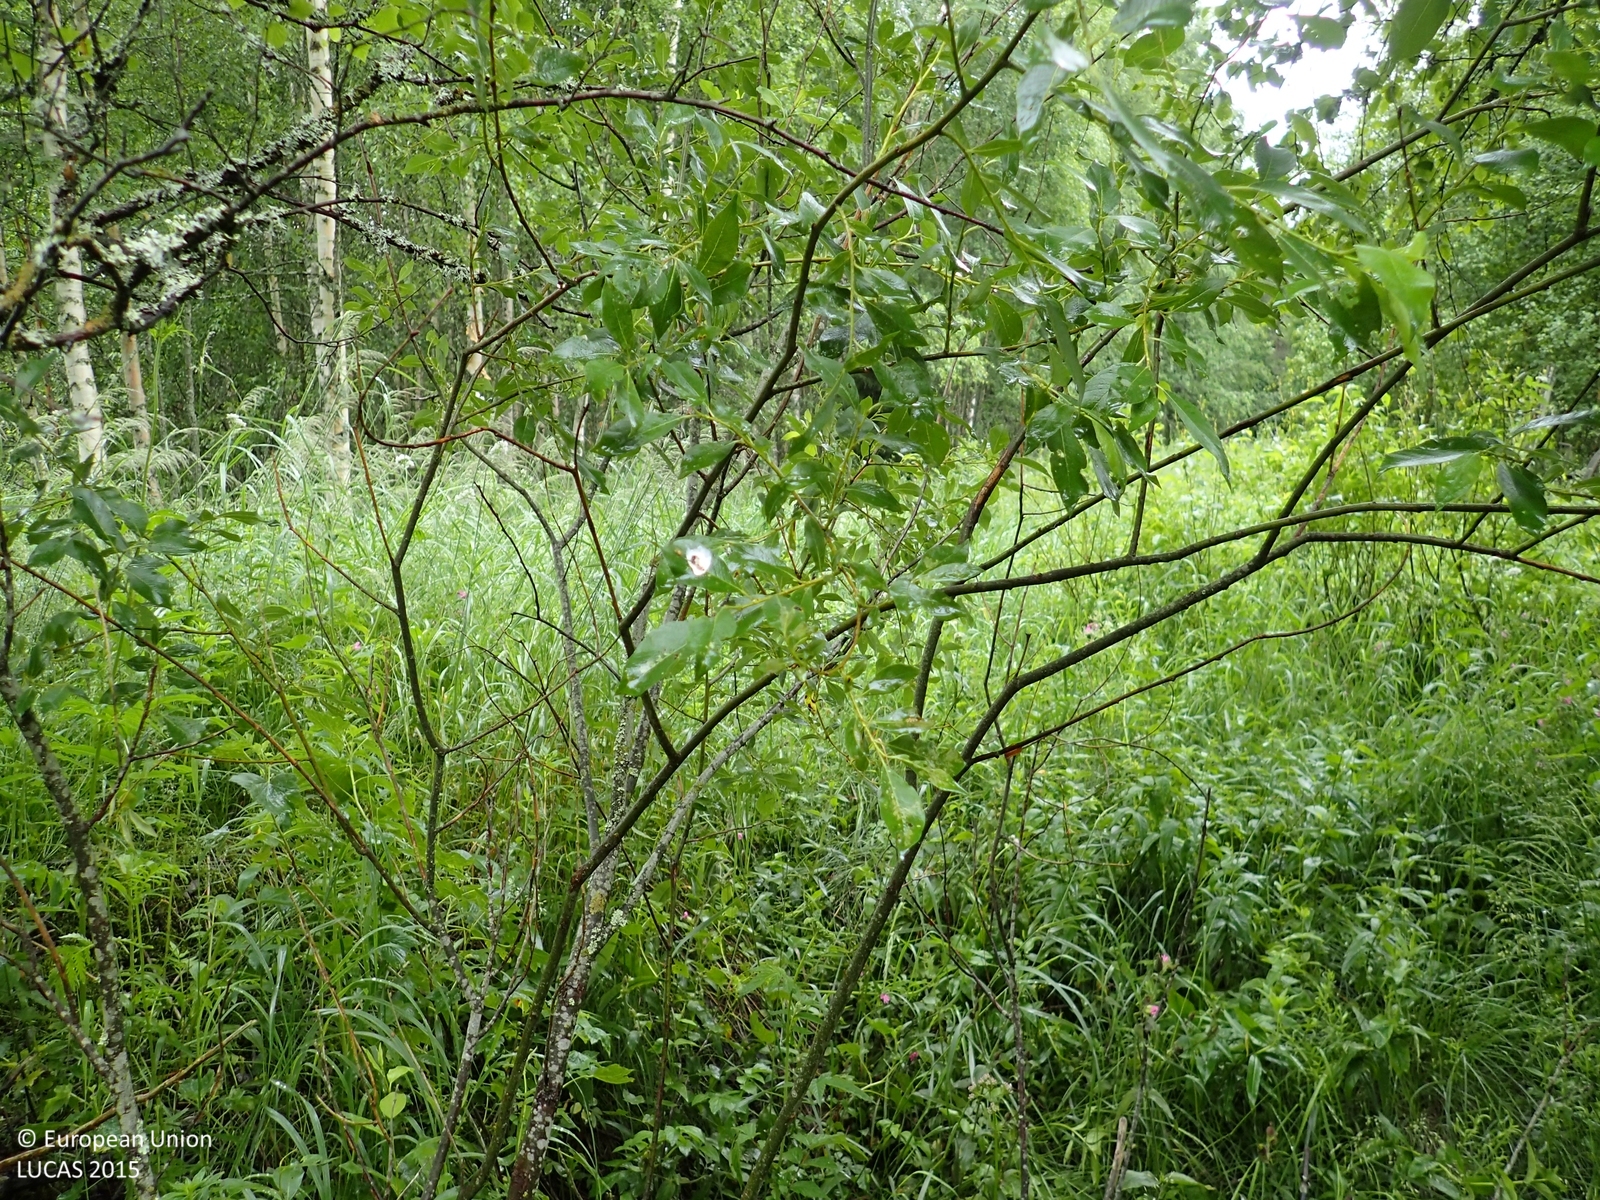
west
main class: Woodland
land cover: Spruce dominated mixed woodland
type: boreal forest
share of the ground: 50 - 75 %
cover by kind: broadleaved forest trees 55 %, shrubs 25 %, coniferous forest trees 20 %
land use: Forestry
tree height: > 5 m
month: July
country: FI
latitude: 62.8642
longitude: 21.7364
